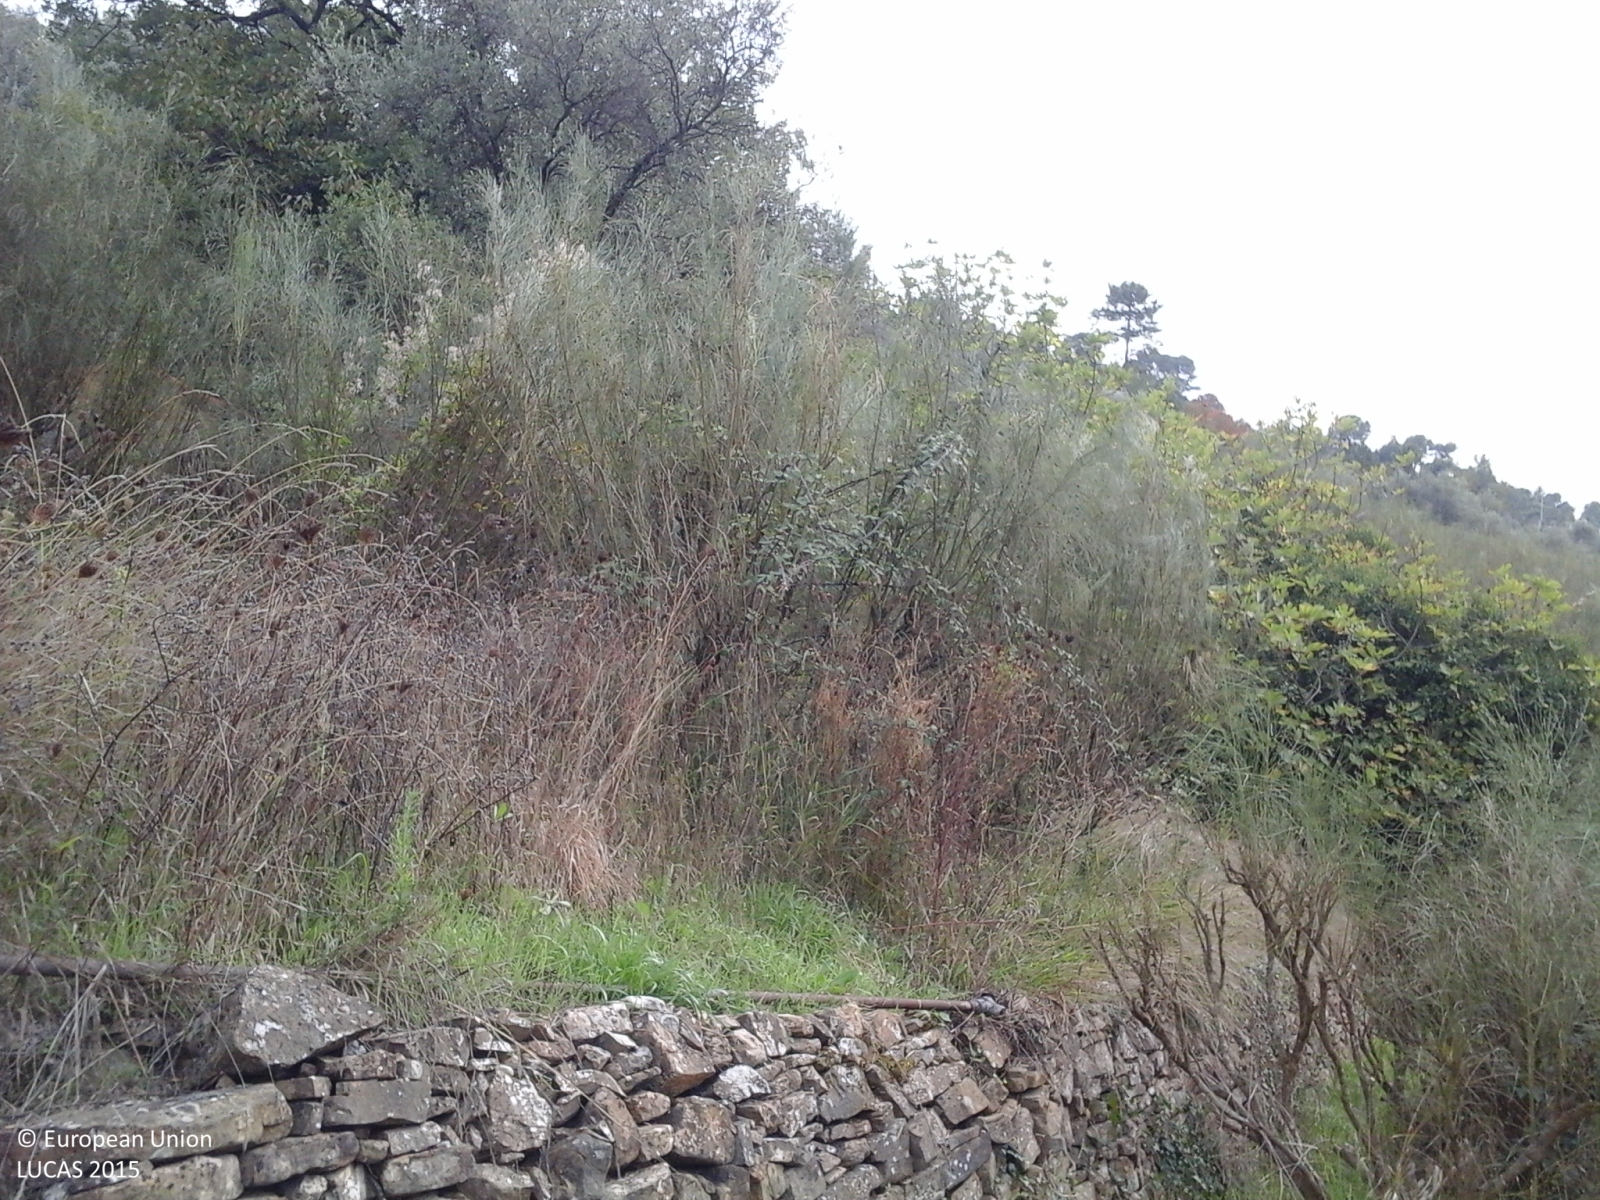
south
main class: Woodland
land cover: Broadleaved woodland
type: thermophilous deciduous forest
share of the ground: > 75 %
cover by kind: broadleaved forest trees 80 %, shrubs 15 %, herbaceous plants 5 %
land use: Semi-natural and natural areas not in use
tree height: > 5 m
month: October
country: IT
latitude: 43.8194
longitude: 7.6807
